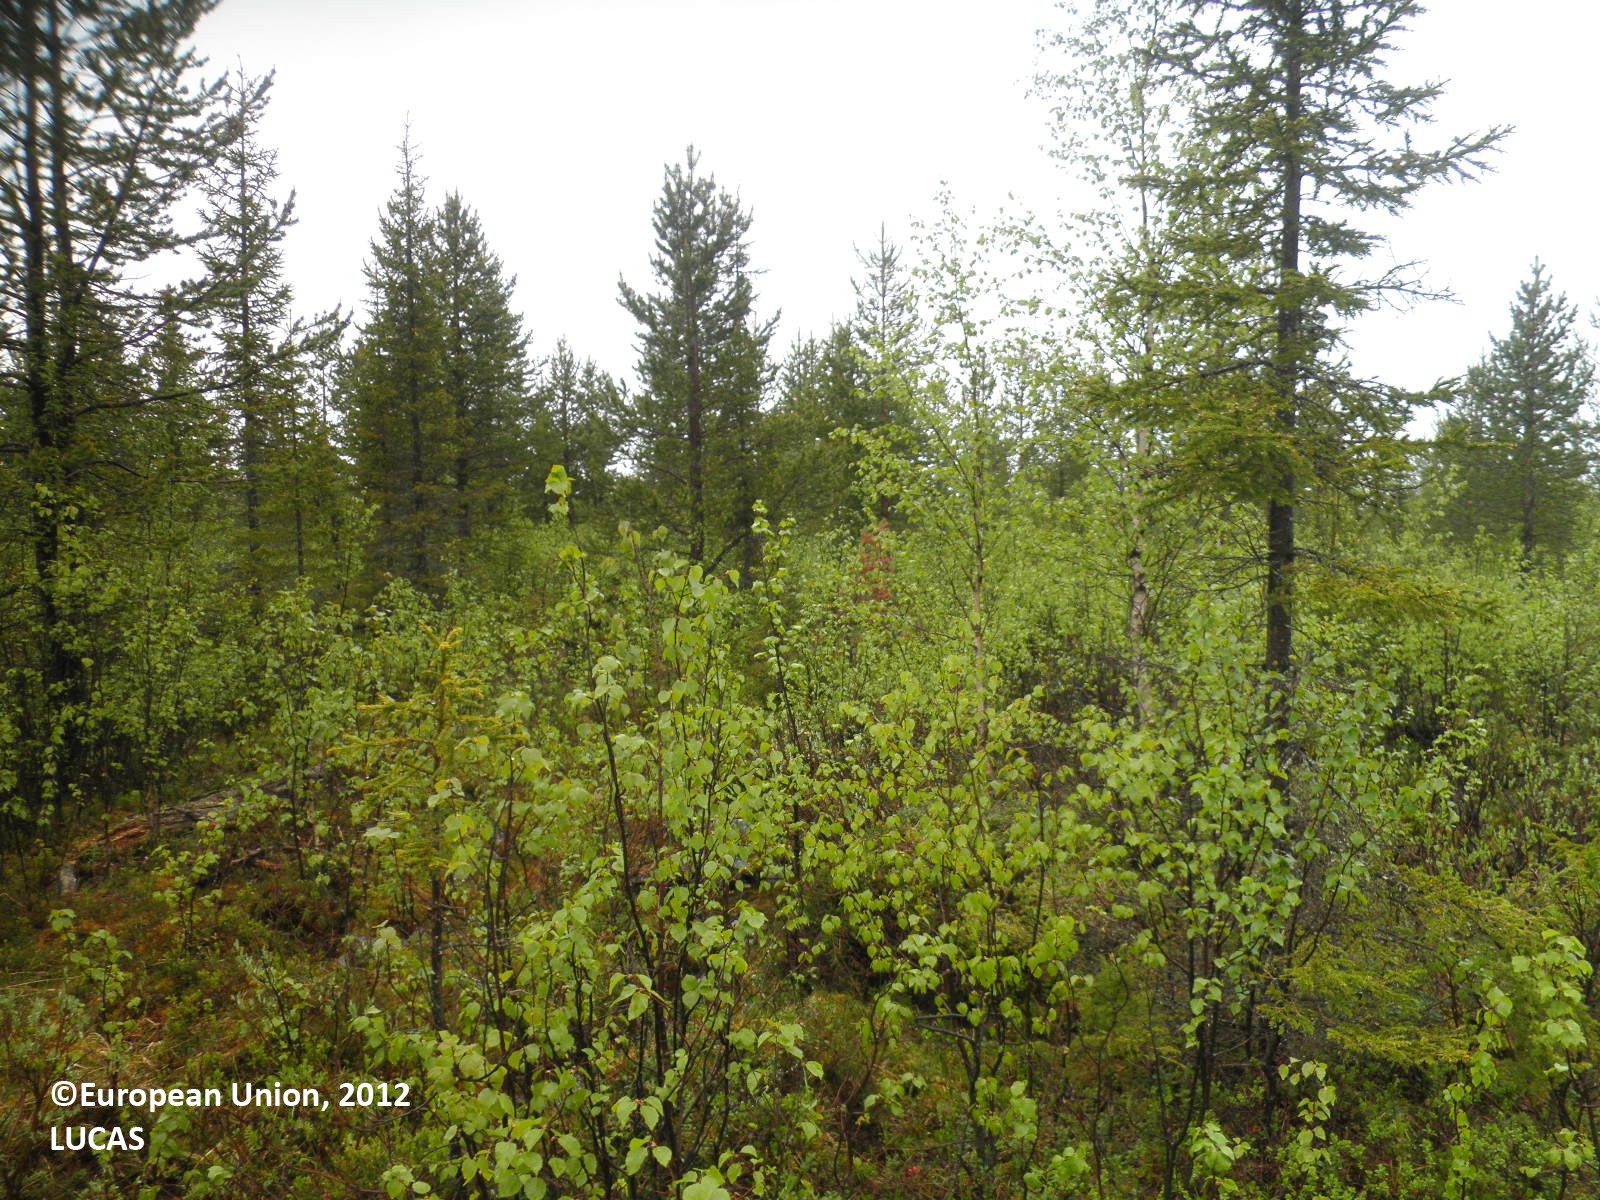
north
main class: Woodland
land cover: Pine dominated mixed woodland
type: boreal forest
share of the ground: 10 - 25 %
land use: Forestry
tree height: > 5 m
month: June
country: FI
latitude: 67.9987
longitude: 25.7617
